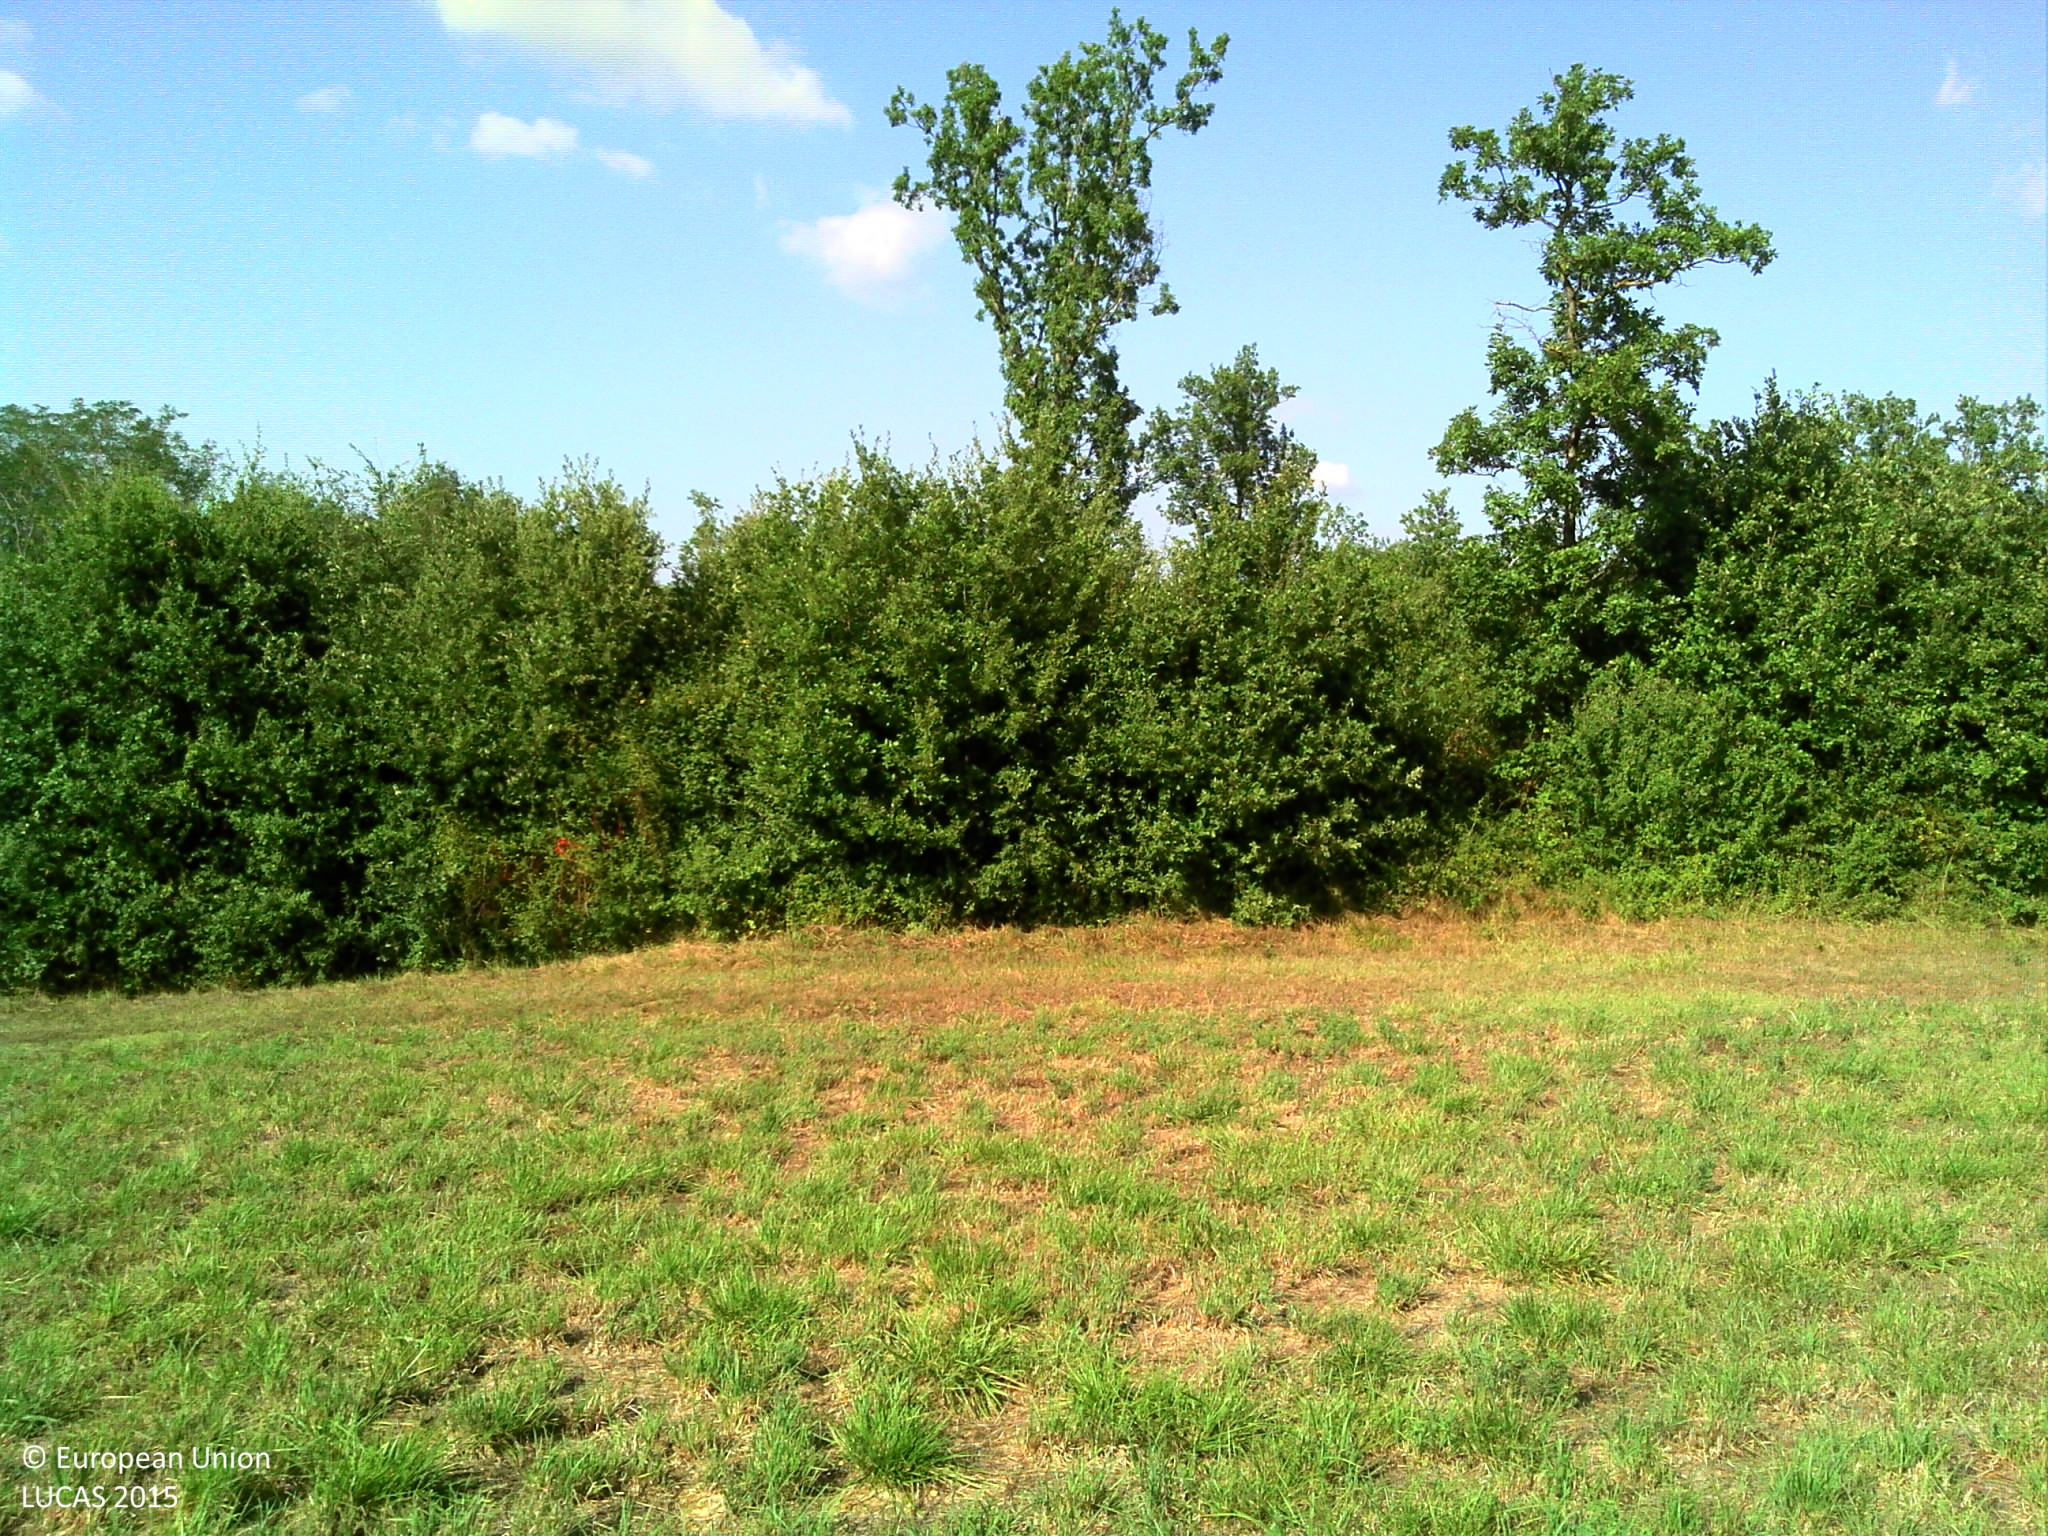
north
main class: Cropland
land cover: Temporary grasslands
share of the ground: > 75 %
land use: Agriculture (excluding fallow land and kitchen gardens)
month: August
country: FR
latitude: 43.9324
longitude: 1.5432
